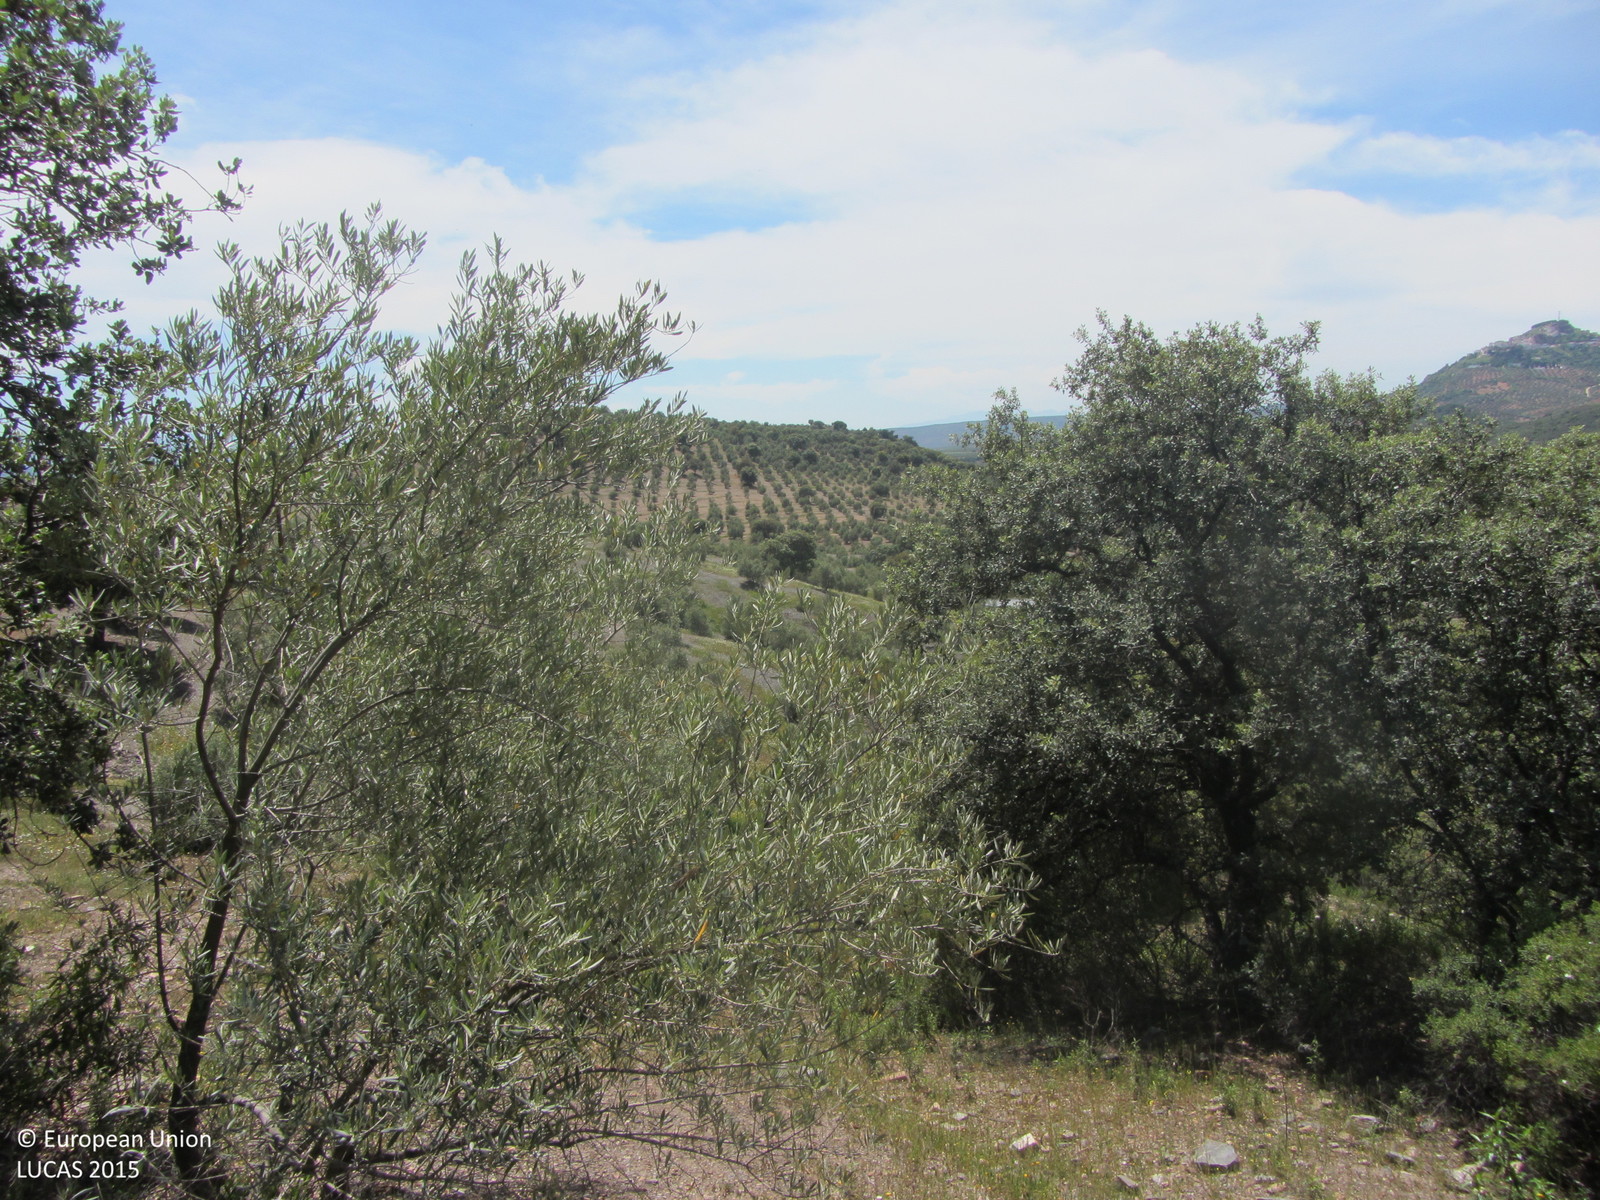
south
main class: Shrubland
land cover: Shrubland with sparse tree cover
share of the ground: 10 - 25 %
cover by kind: herbaceous plants 35 %, consolidated bare surface 35 %, shrubs 25 %, broadleaved forest trees 5 %
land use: Semi-natural and natural areas not in use
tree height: < 5 m
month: May
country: ES
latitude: 38.3350
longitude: -3.0088
